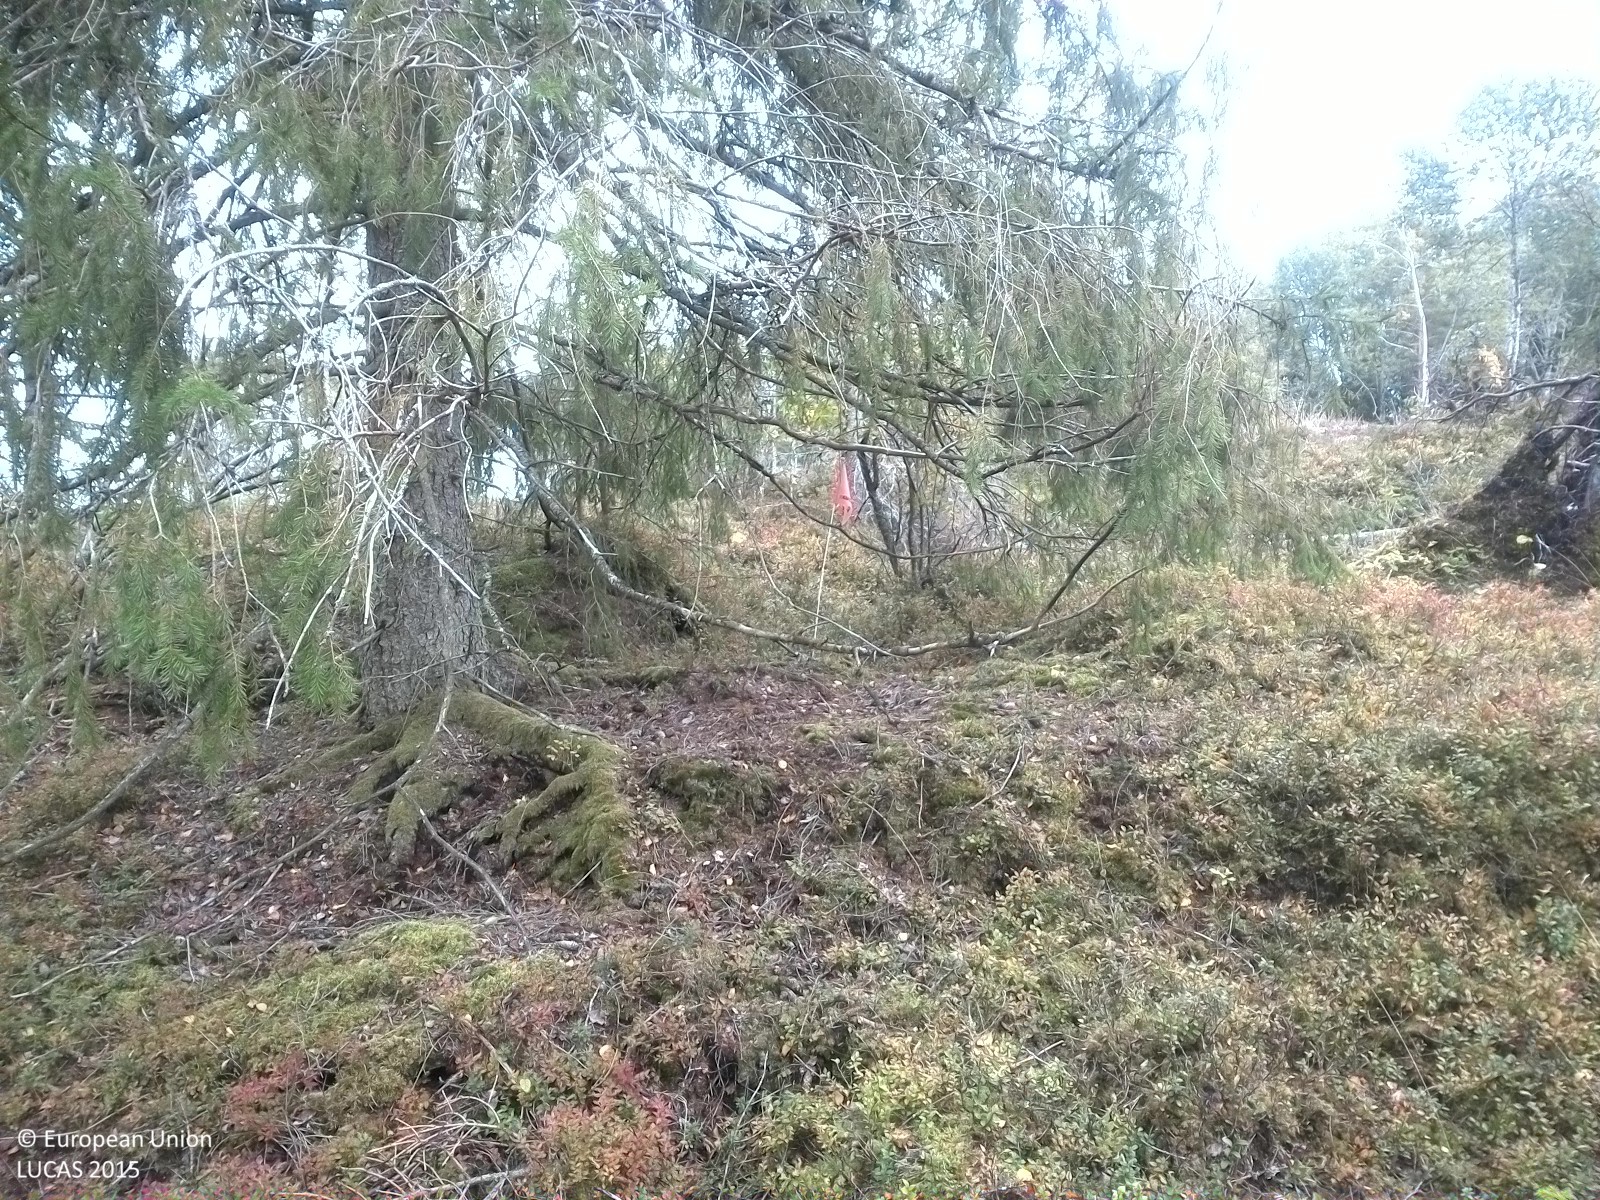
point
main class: Woodland
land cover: Spruce dominated mixed woodland
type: boreal forest
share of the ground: 25 - 50 %
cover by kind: herbaceous plants 45 %, coniferous forest trees 20 %, broadleaved forest trees 20 %, lichens and mosses 10 %, shrubs 5 %
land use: Forestry
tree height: > 5 m
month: September
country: SE
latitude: 58.9117
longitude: 15.6708
